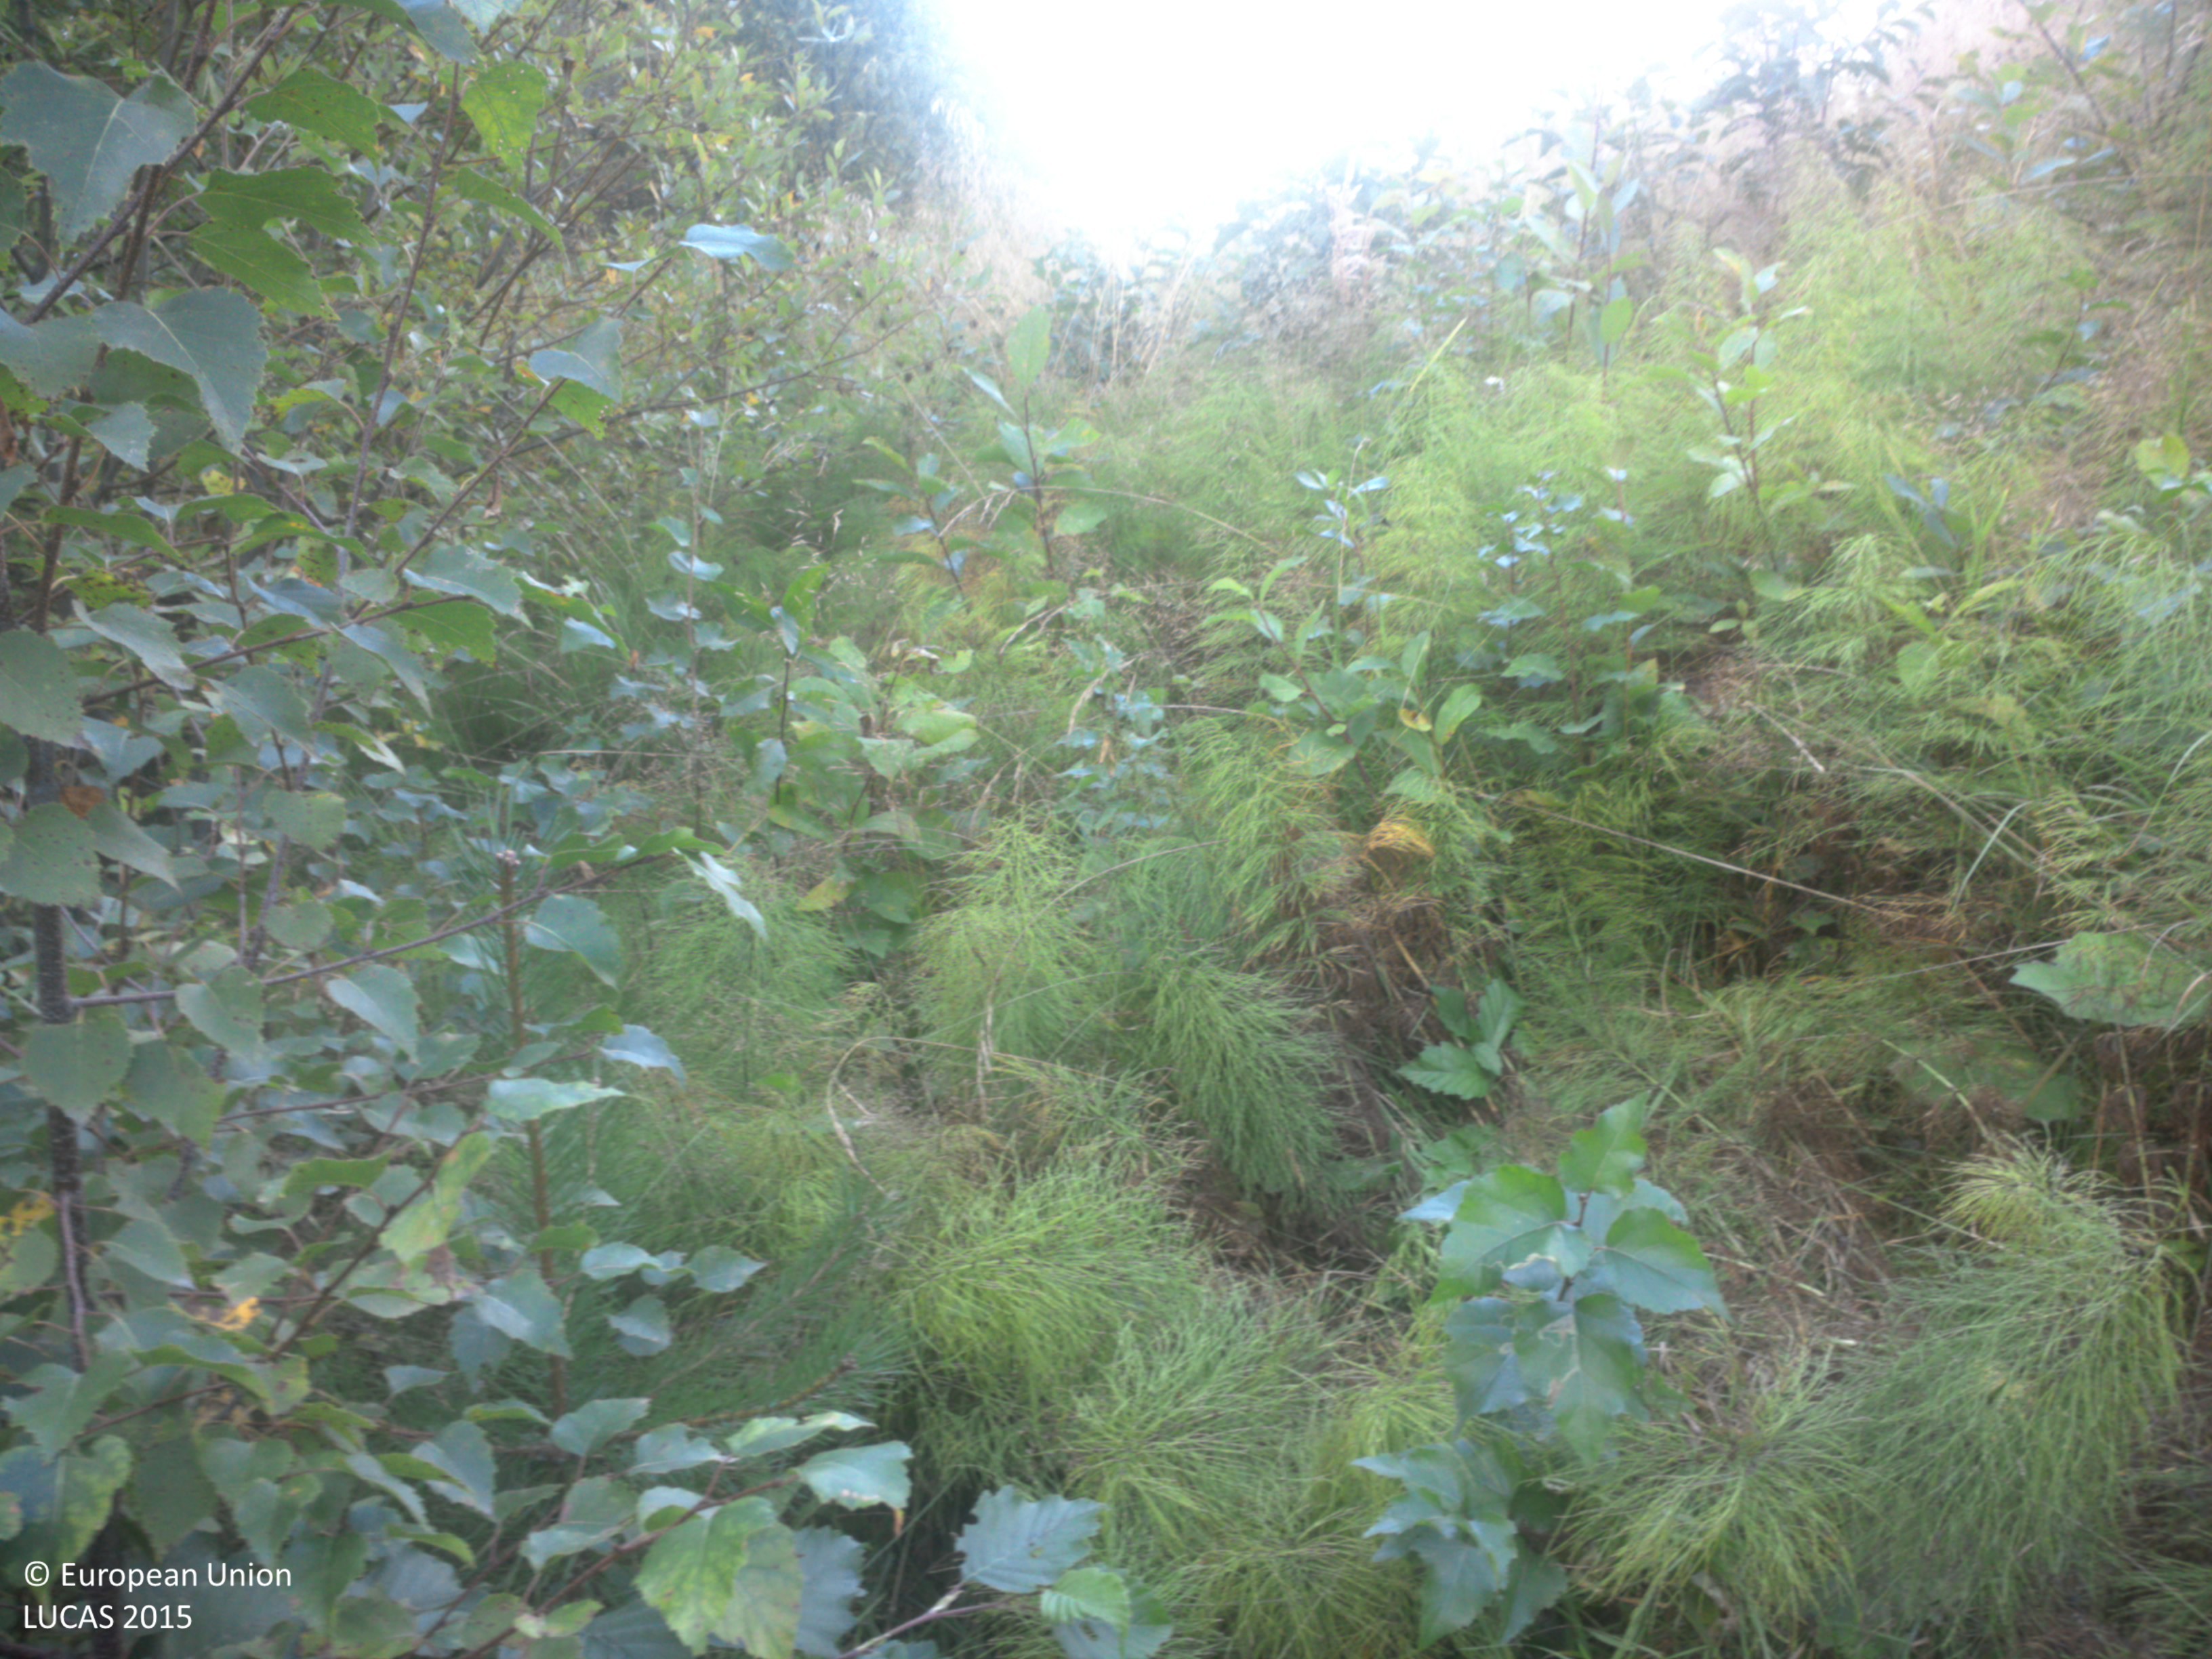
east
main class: Woodland
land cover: Broadleaved woodland
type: hemiboreal forest and nemoral coniferous forest and mixed broadleaved-coniferous forest
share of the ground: 50 - 75 %
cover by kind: broadleaved forest trees 50 %, herbaceous plants 45 %, coniferous forest trees 5 %
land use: Semi-natural and natural areas not in use
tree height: < 5 m
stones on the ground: < 10 %
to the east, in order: Broadleaved woodland; Electric lines; Grass margins; Paved roads, cycling and walking lanes; Grassland without tree/shrub cover; Ditches and canals; Electric lines; Broadleaved woodland; Grassland without tree/shrub cover; Ditches and canals; Grassland without tree/shrub cover; Artificial constructions in urban areas; Broadleaved woodland; Grassland without tree/shrub cover; Electric lines; Grassland without tree/shrub cover; Ditches and canals; Grassland with sparse tree/shrub cover; Electric lines; Grassland with sparse tree/shrub cover
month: August
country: SE
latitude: 63.8625
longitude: 20.0104
